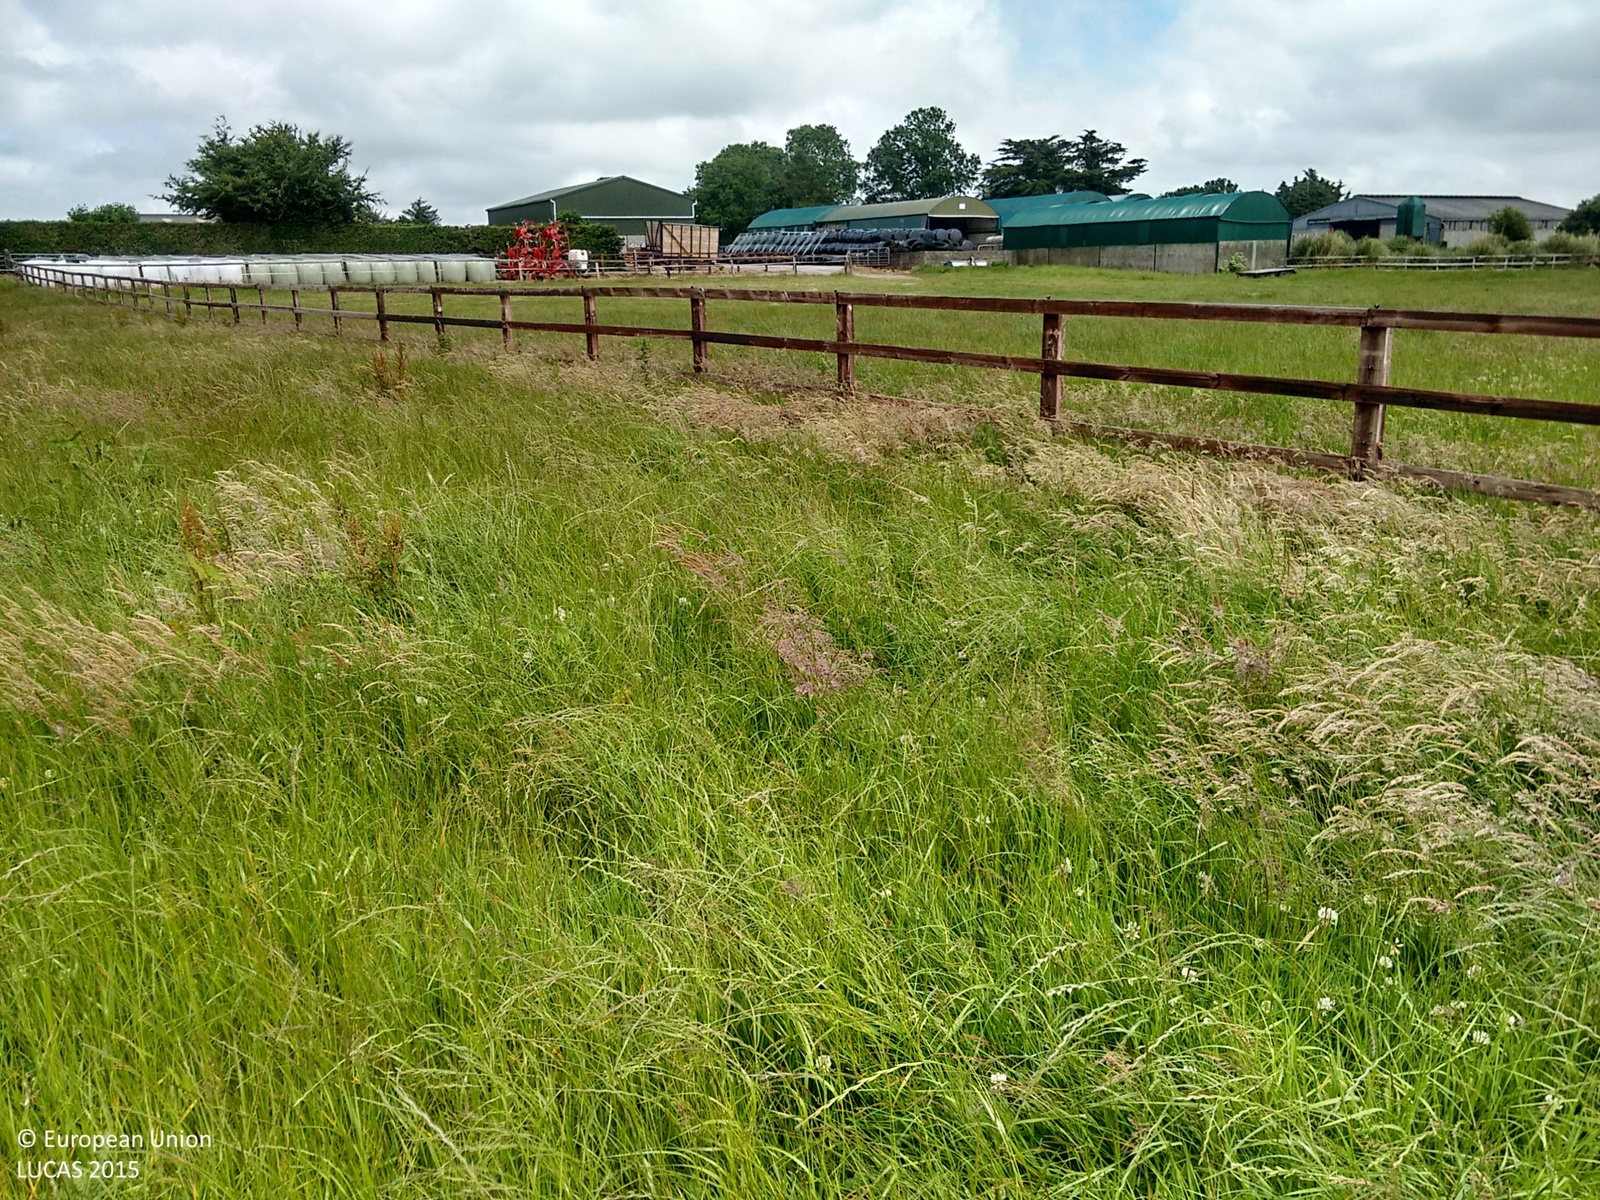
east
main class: Grassland
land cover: Grassland without tree/shrub cover
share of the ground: > 75 %
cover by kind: herbaceous plants 100 %
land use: Agriculture (excluding fallow land and kitchen gardens)
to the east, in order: Grassland without tree/shrub cover; Fences; Grassland without tree/shrub cover; Artificial constructions in urban areas; Broadleaved woodland
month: June
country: IE
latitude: 52.0999
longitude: -8.1824
